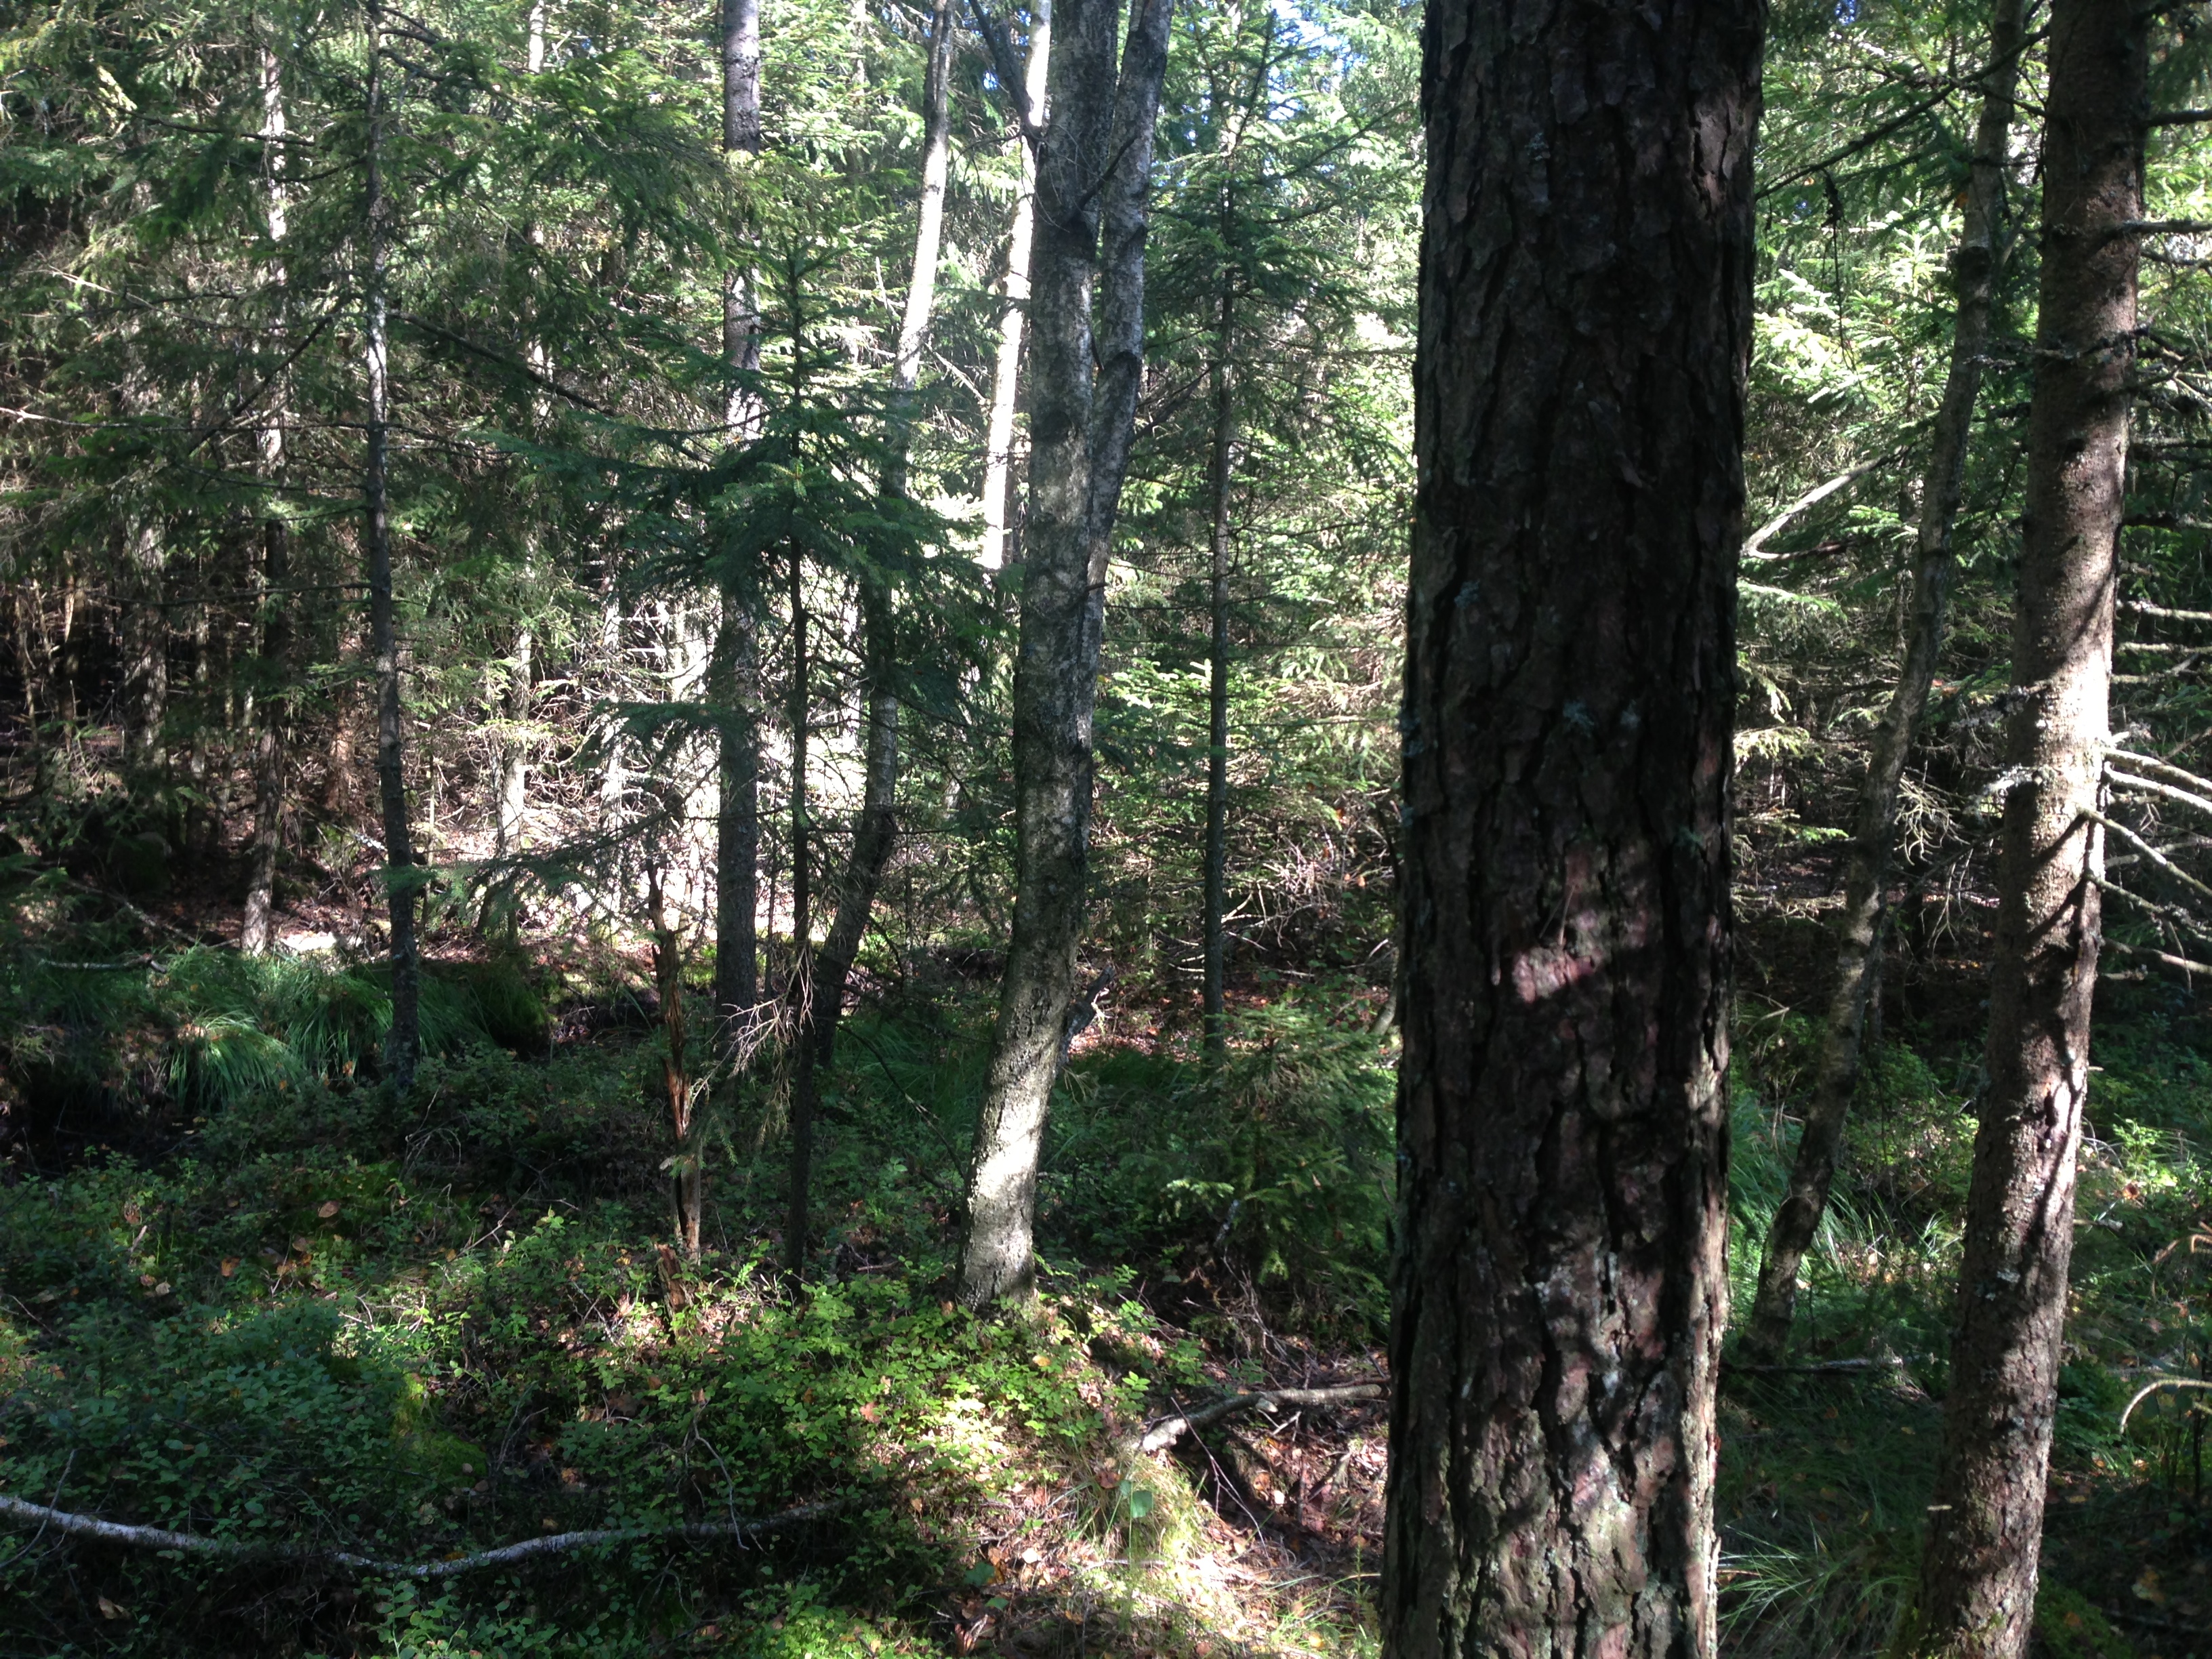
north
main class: Woodland
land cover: Pine dominated mixed woodland
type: boreal forest
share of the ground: > 75 %
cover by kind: coniferous forest trees 50 %, broadleaved forest trees 30 %, shrubs 20 %
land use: Forestry
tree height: > 5 m
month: September
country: SE
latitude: 57.1183
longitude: 13.2497
